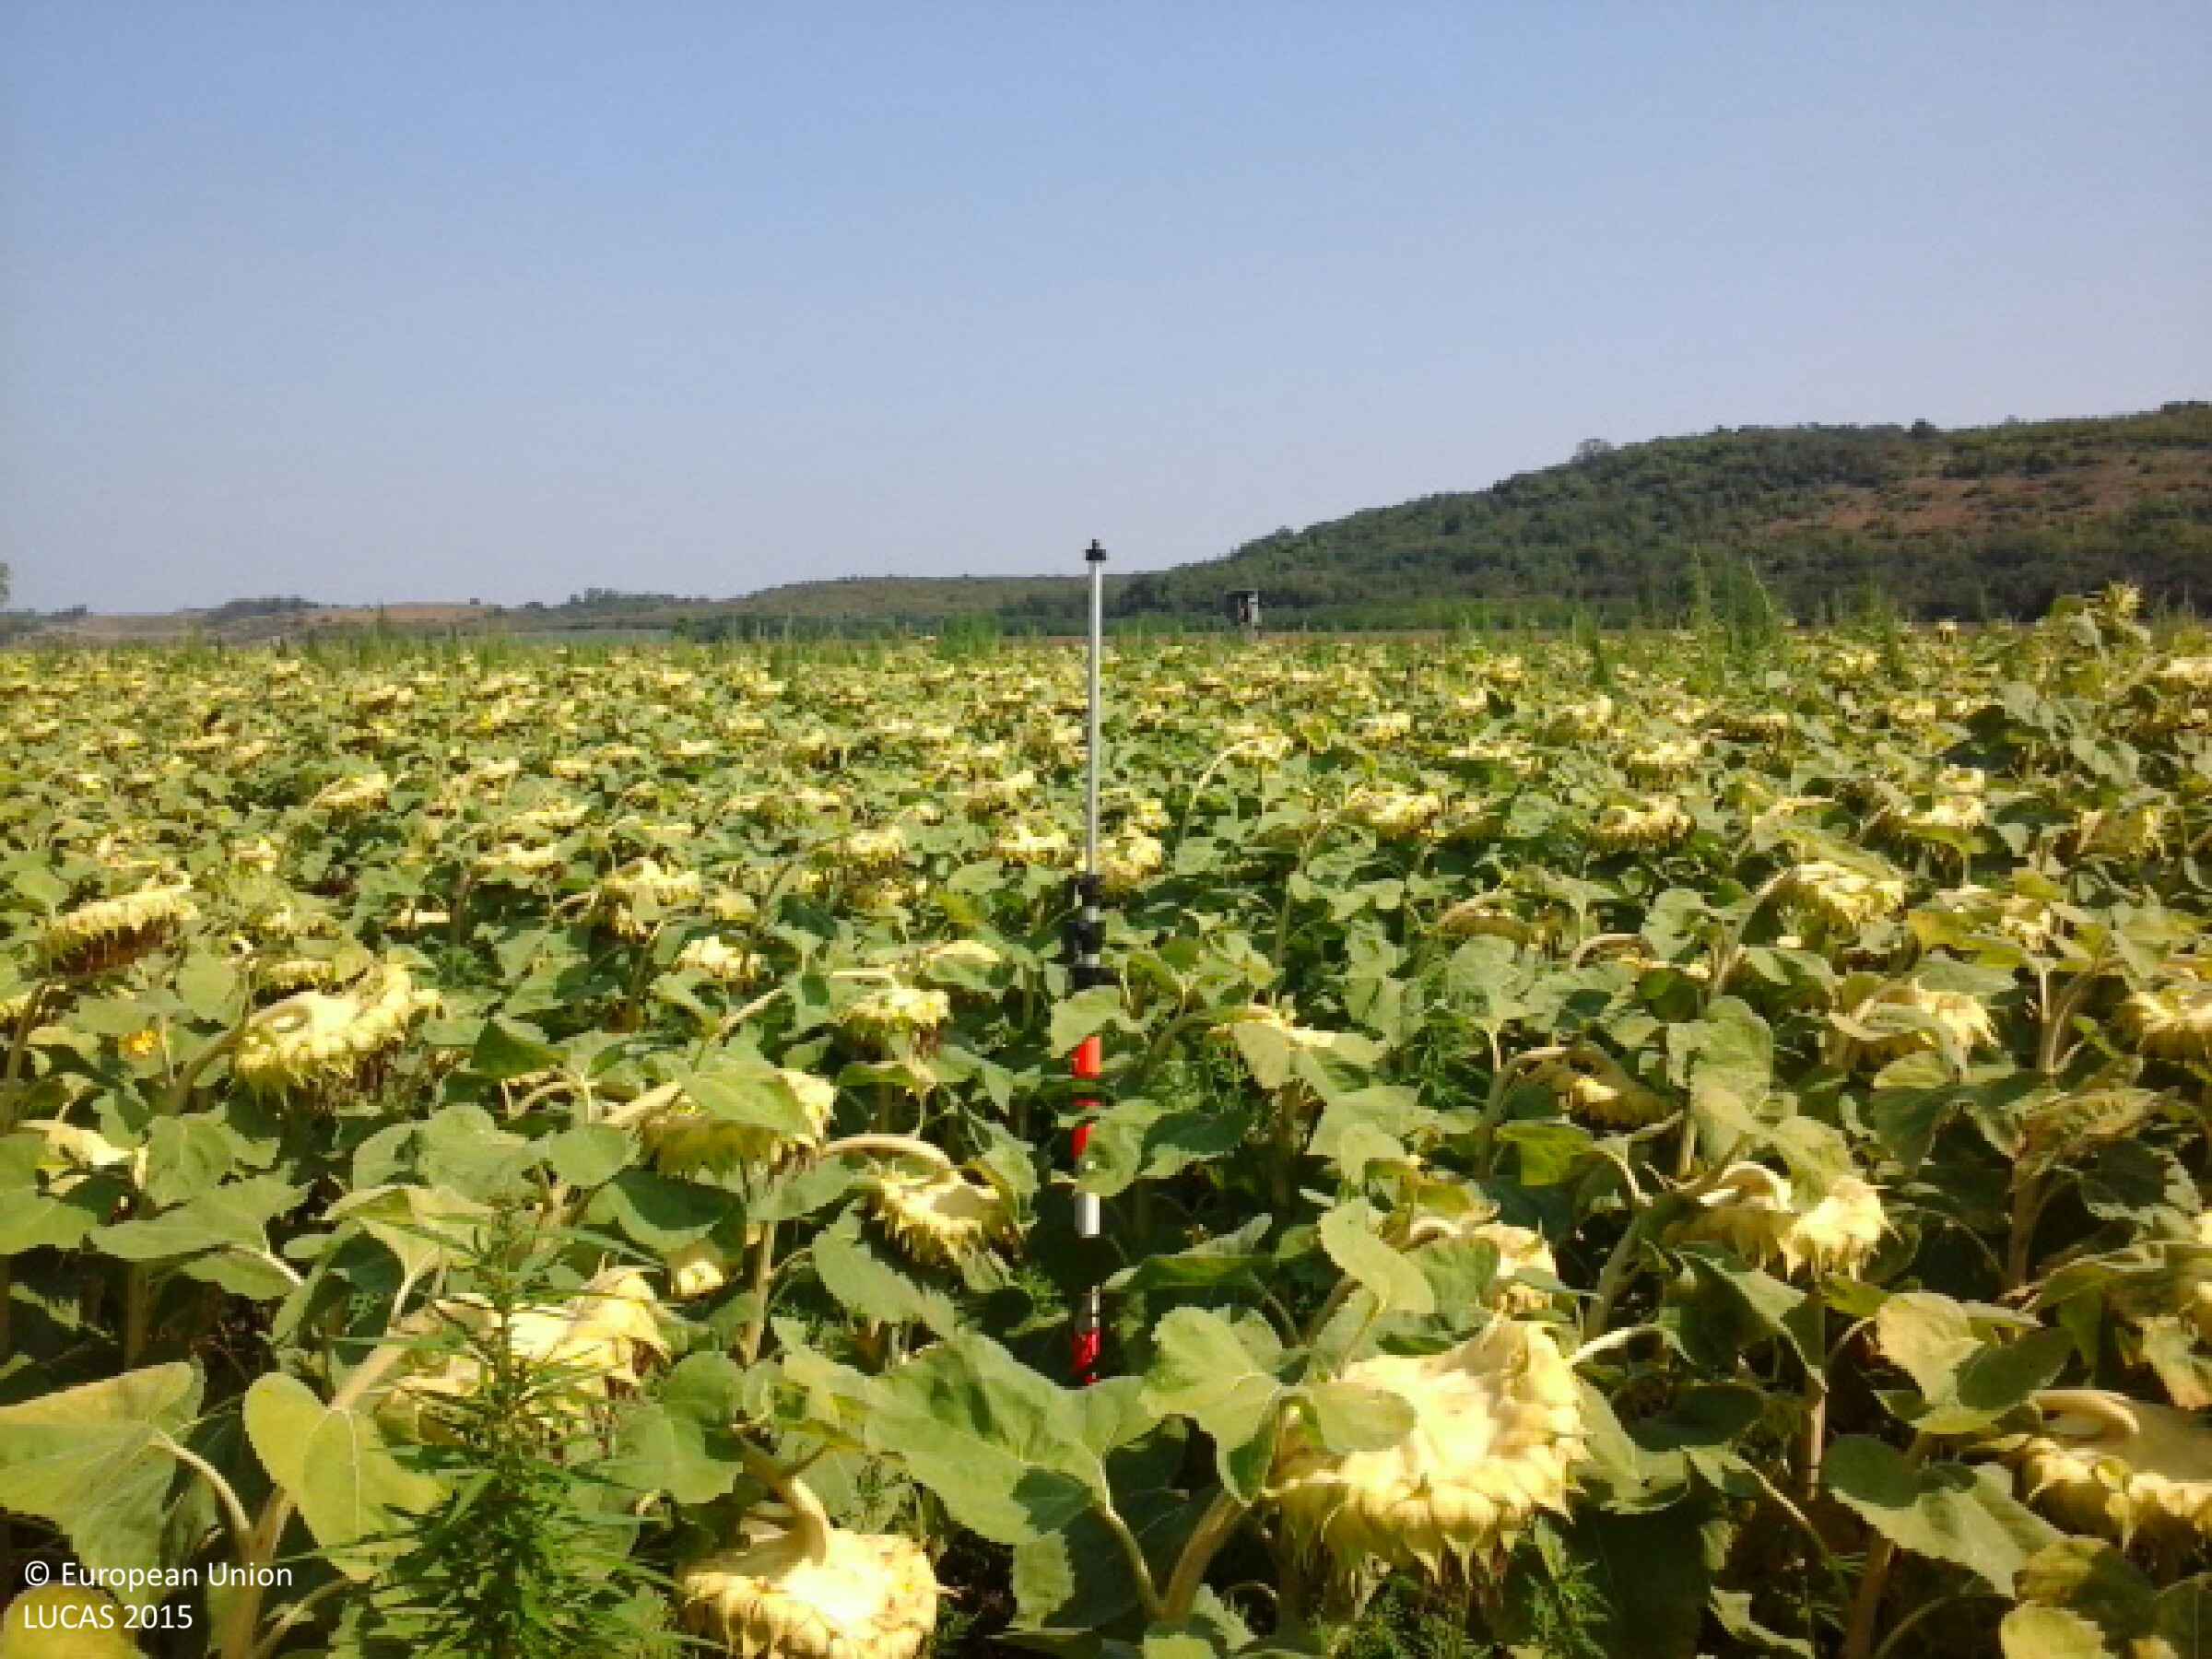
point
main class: Cropland
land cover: Sunflower
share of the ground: > 75 %
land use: Agriculture (excluding fallow land and kitchen gardens)
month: August
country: HU
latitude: 47.4414
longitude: 18.5137
